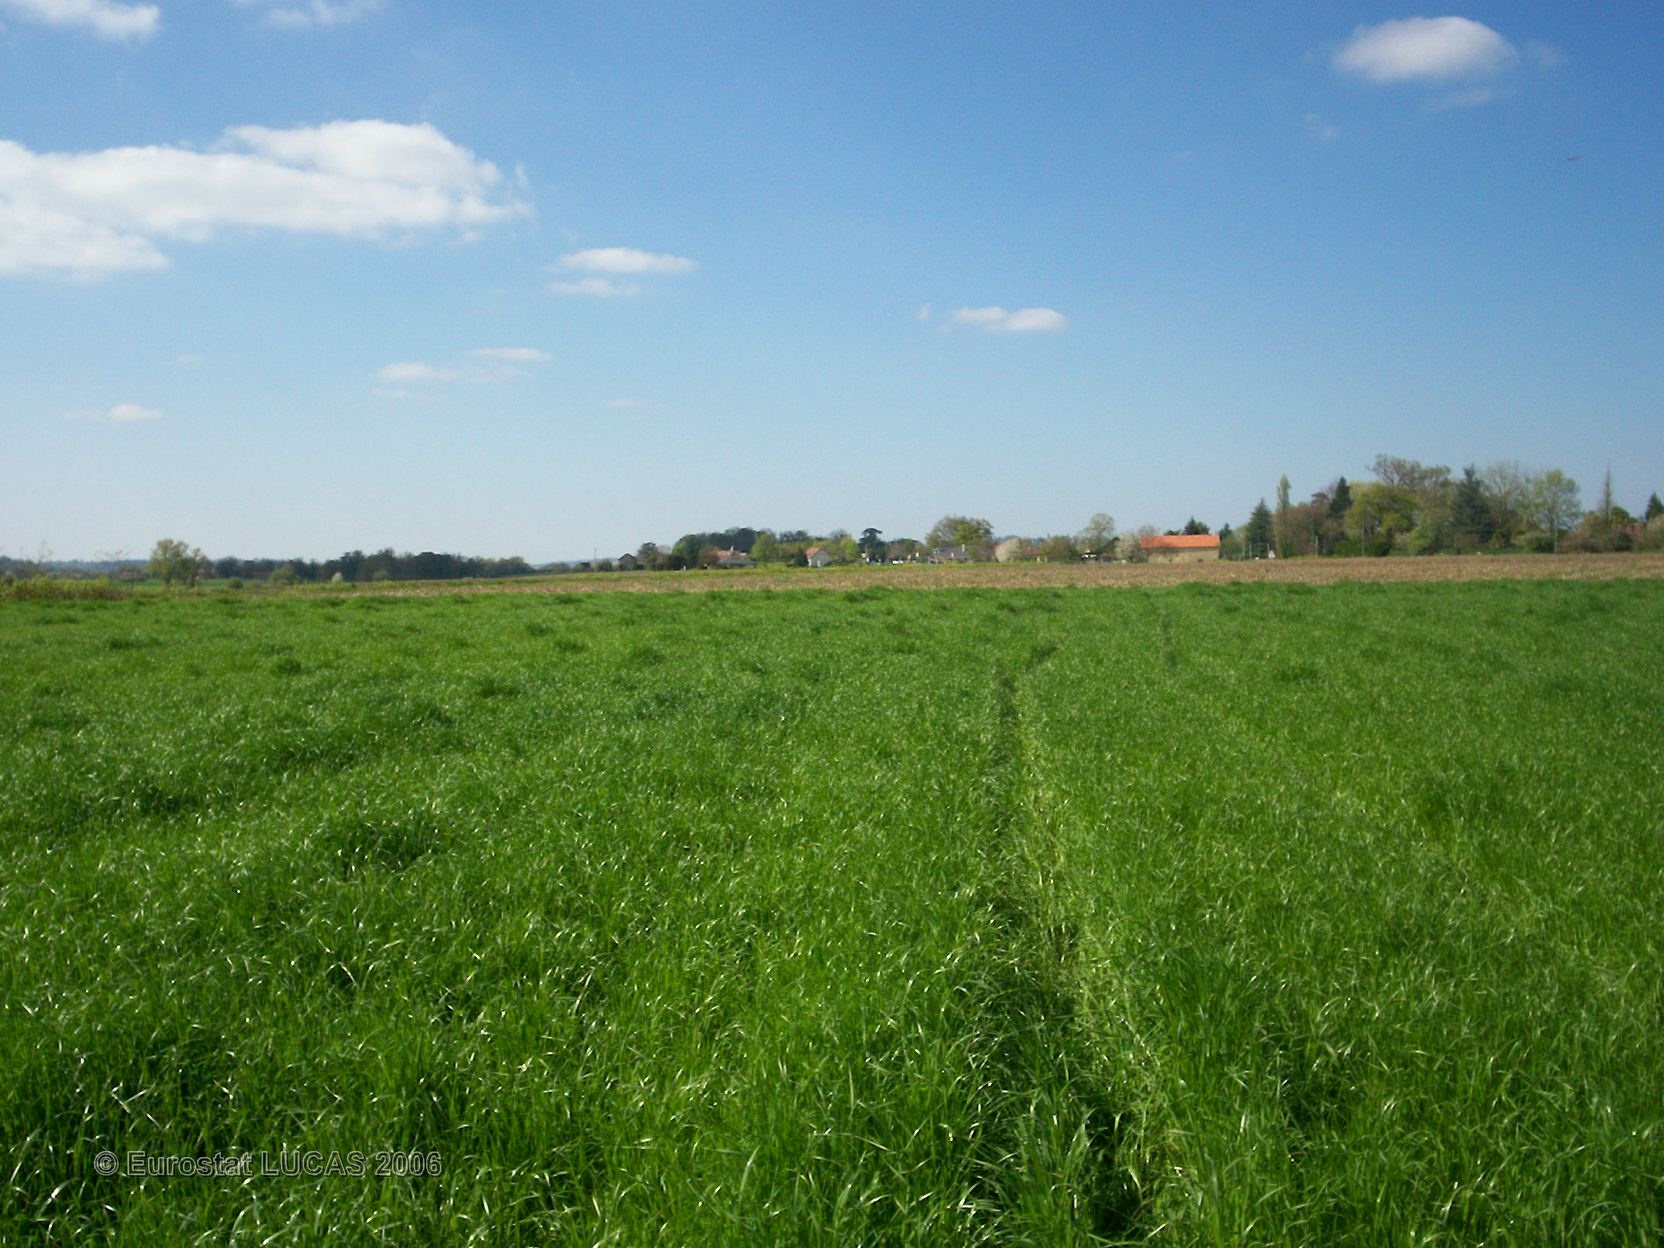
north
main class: Cropland
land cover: Other leguminous and mixtures for fodder
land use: Agriculture (excluding fallow land and kitchen gardens)
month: April
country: FR
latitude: 43.4345
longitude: -0.3230
